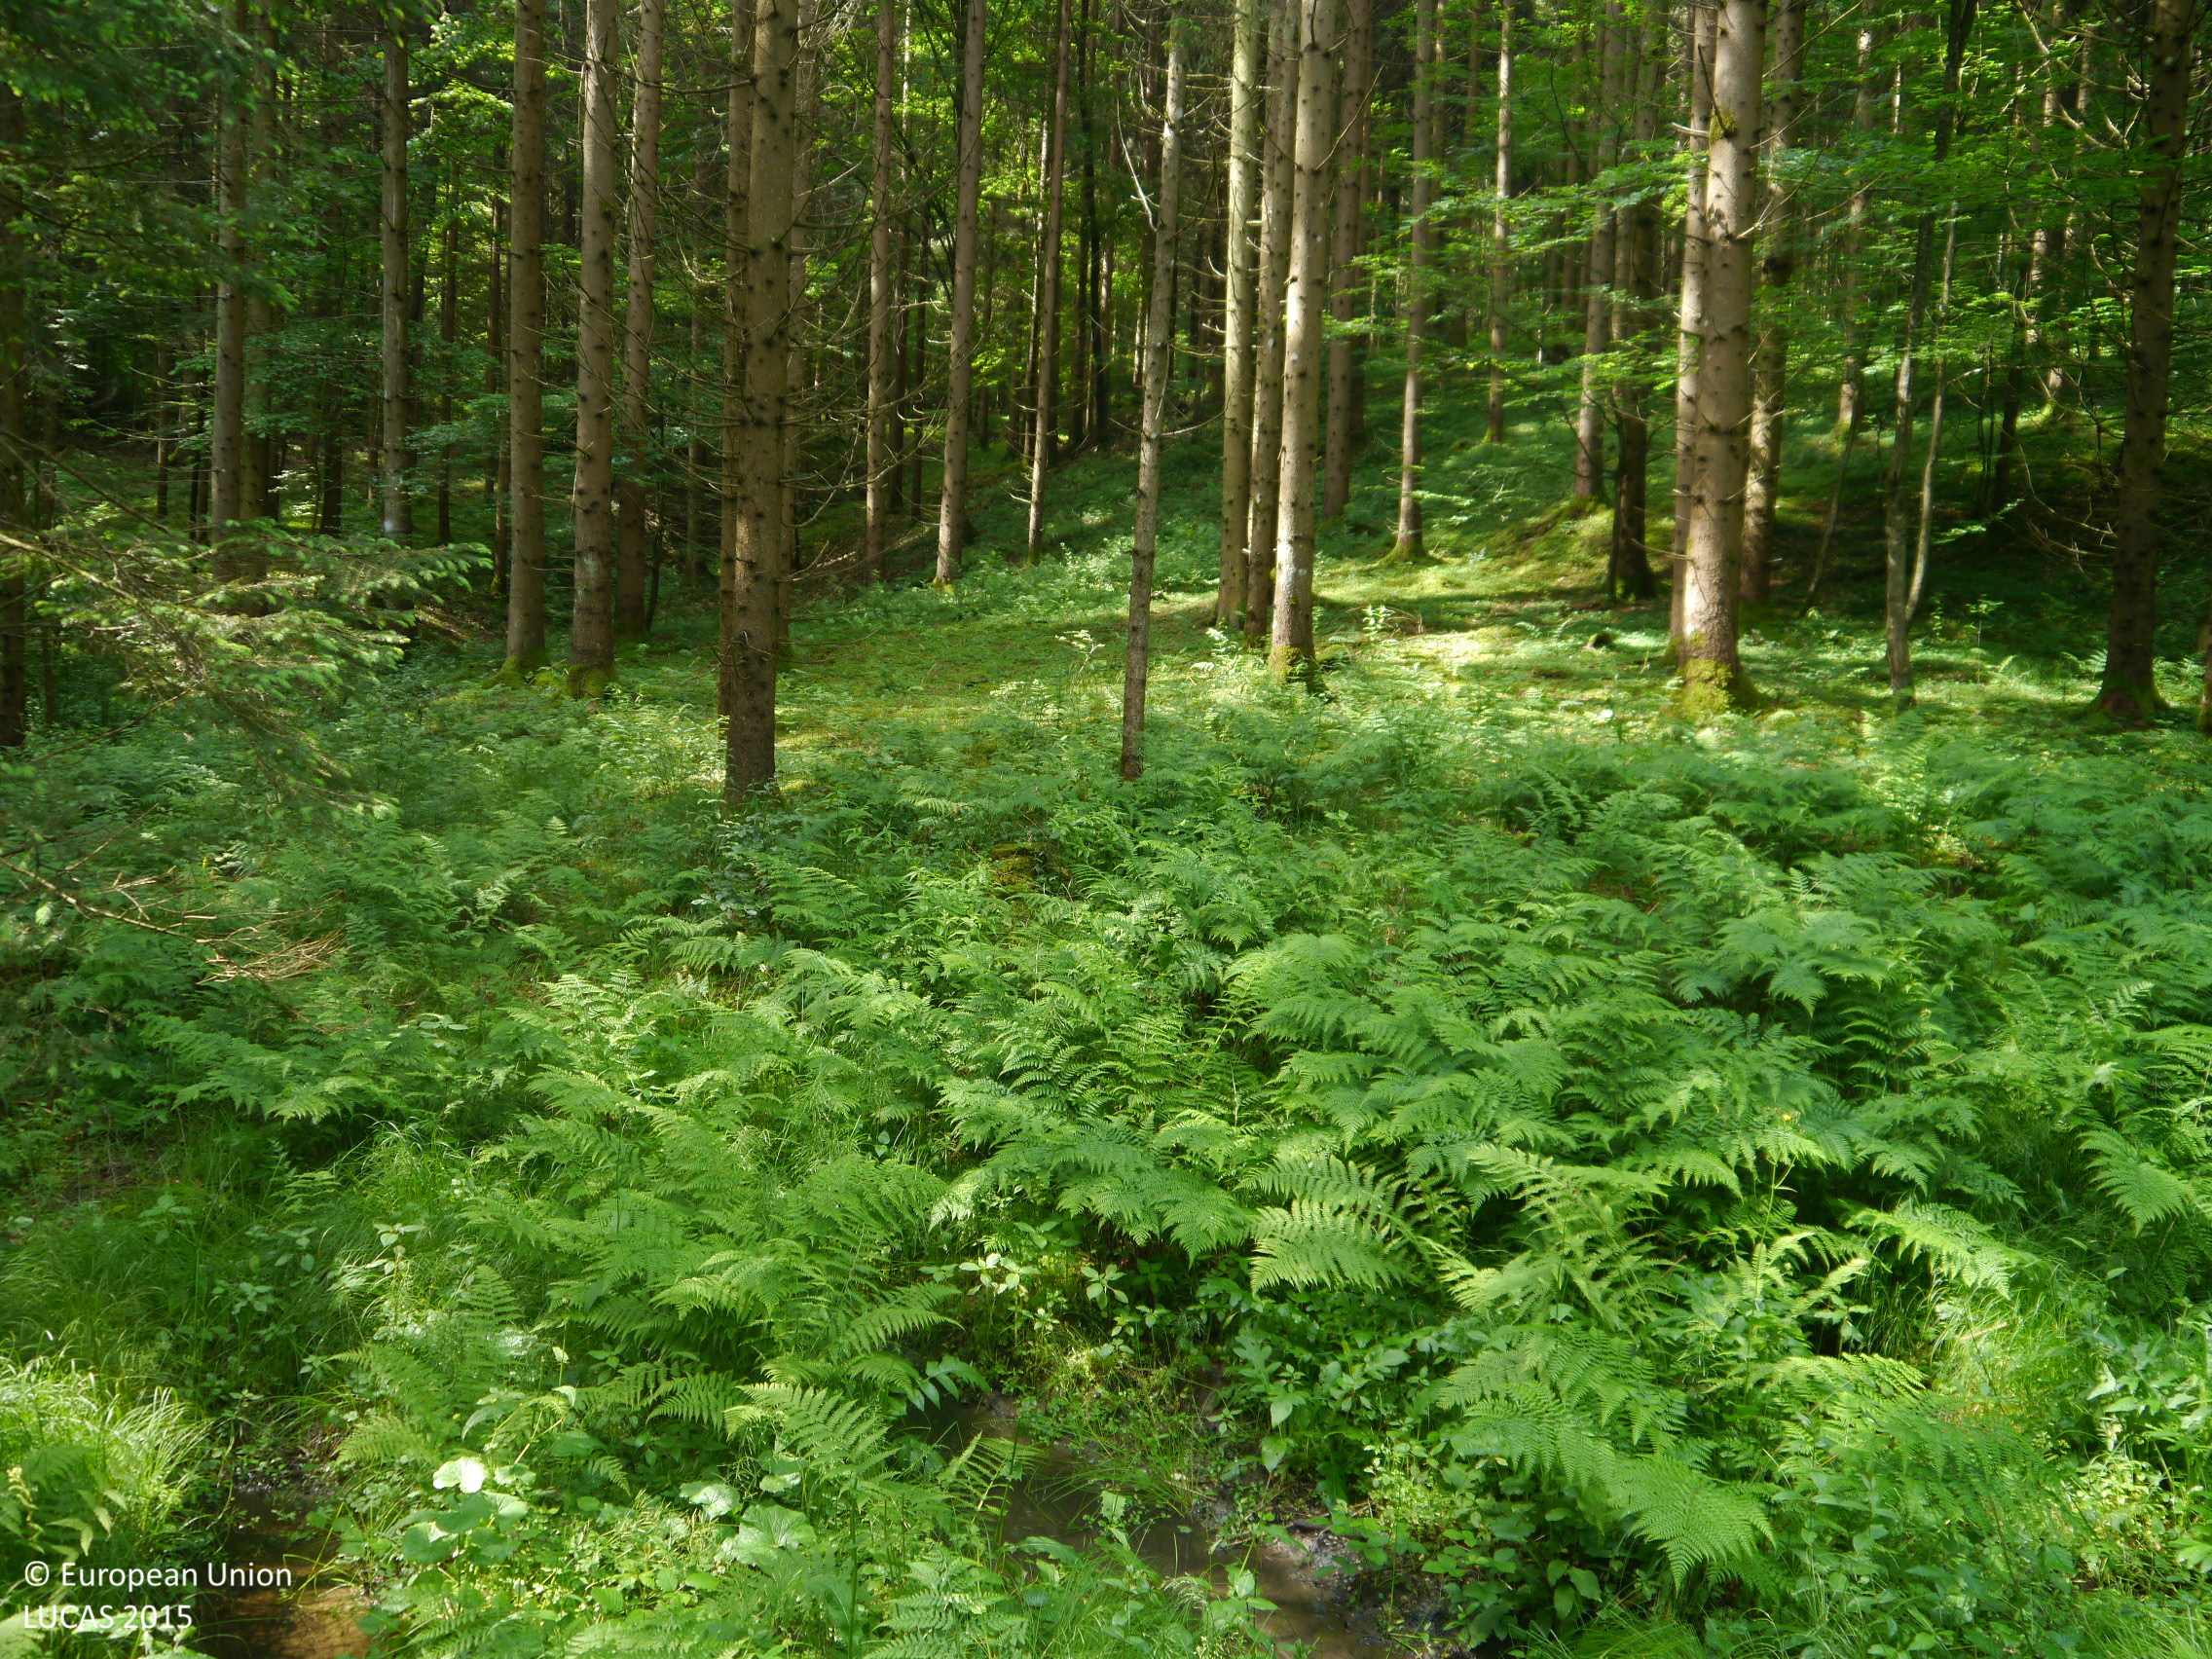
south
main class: Woodland
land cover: Spruce dominated coniferous woodland
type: hemiboreal forest and nemoral coniferous forest and mixed broadleaved-coniferous forest
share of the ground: > 75 %
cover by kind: coniferous forest trees 90 %, broadleaved forest trees 5 %, herbaceous plants 5 %
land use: Forestry
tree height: > 5 m
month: June
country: AT
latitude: 46.9454
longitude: 15.5834
